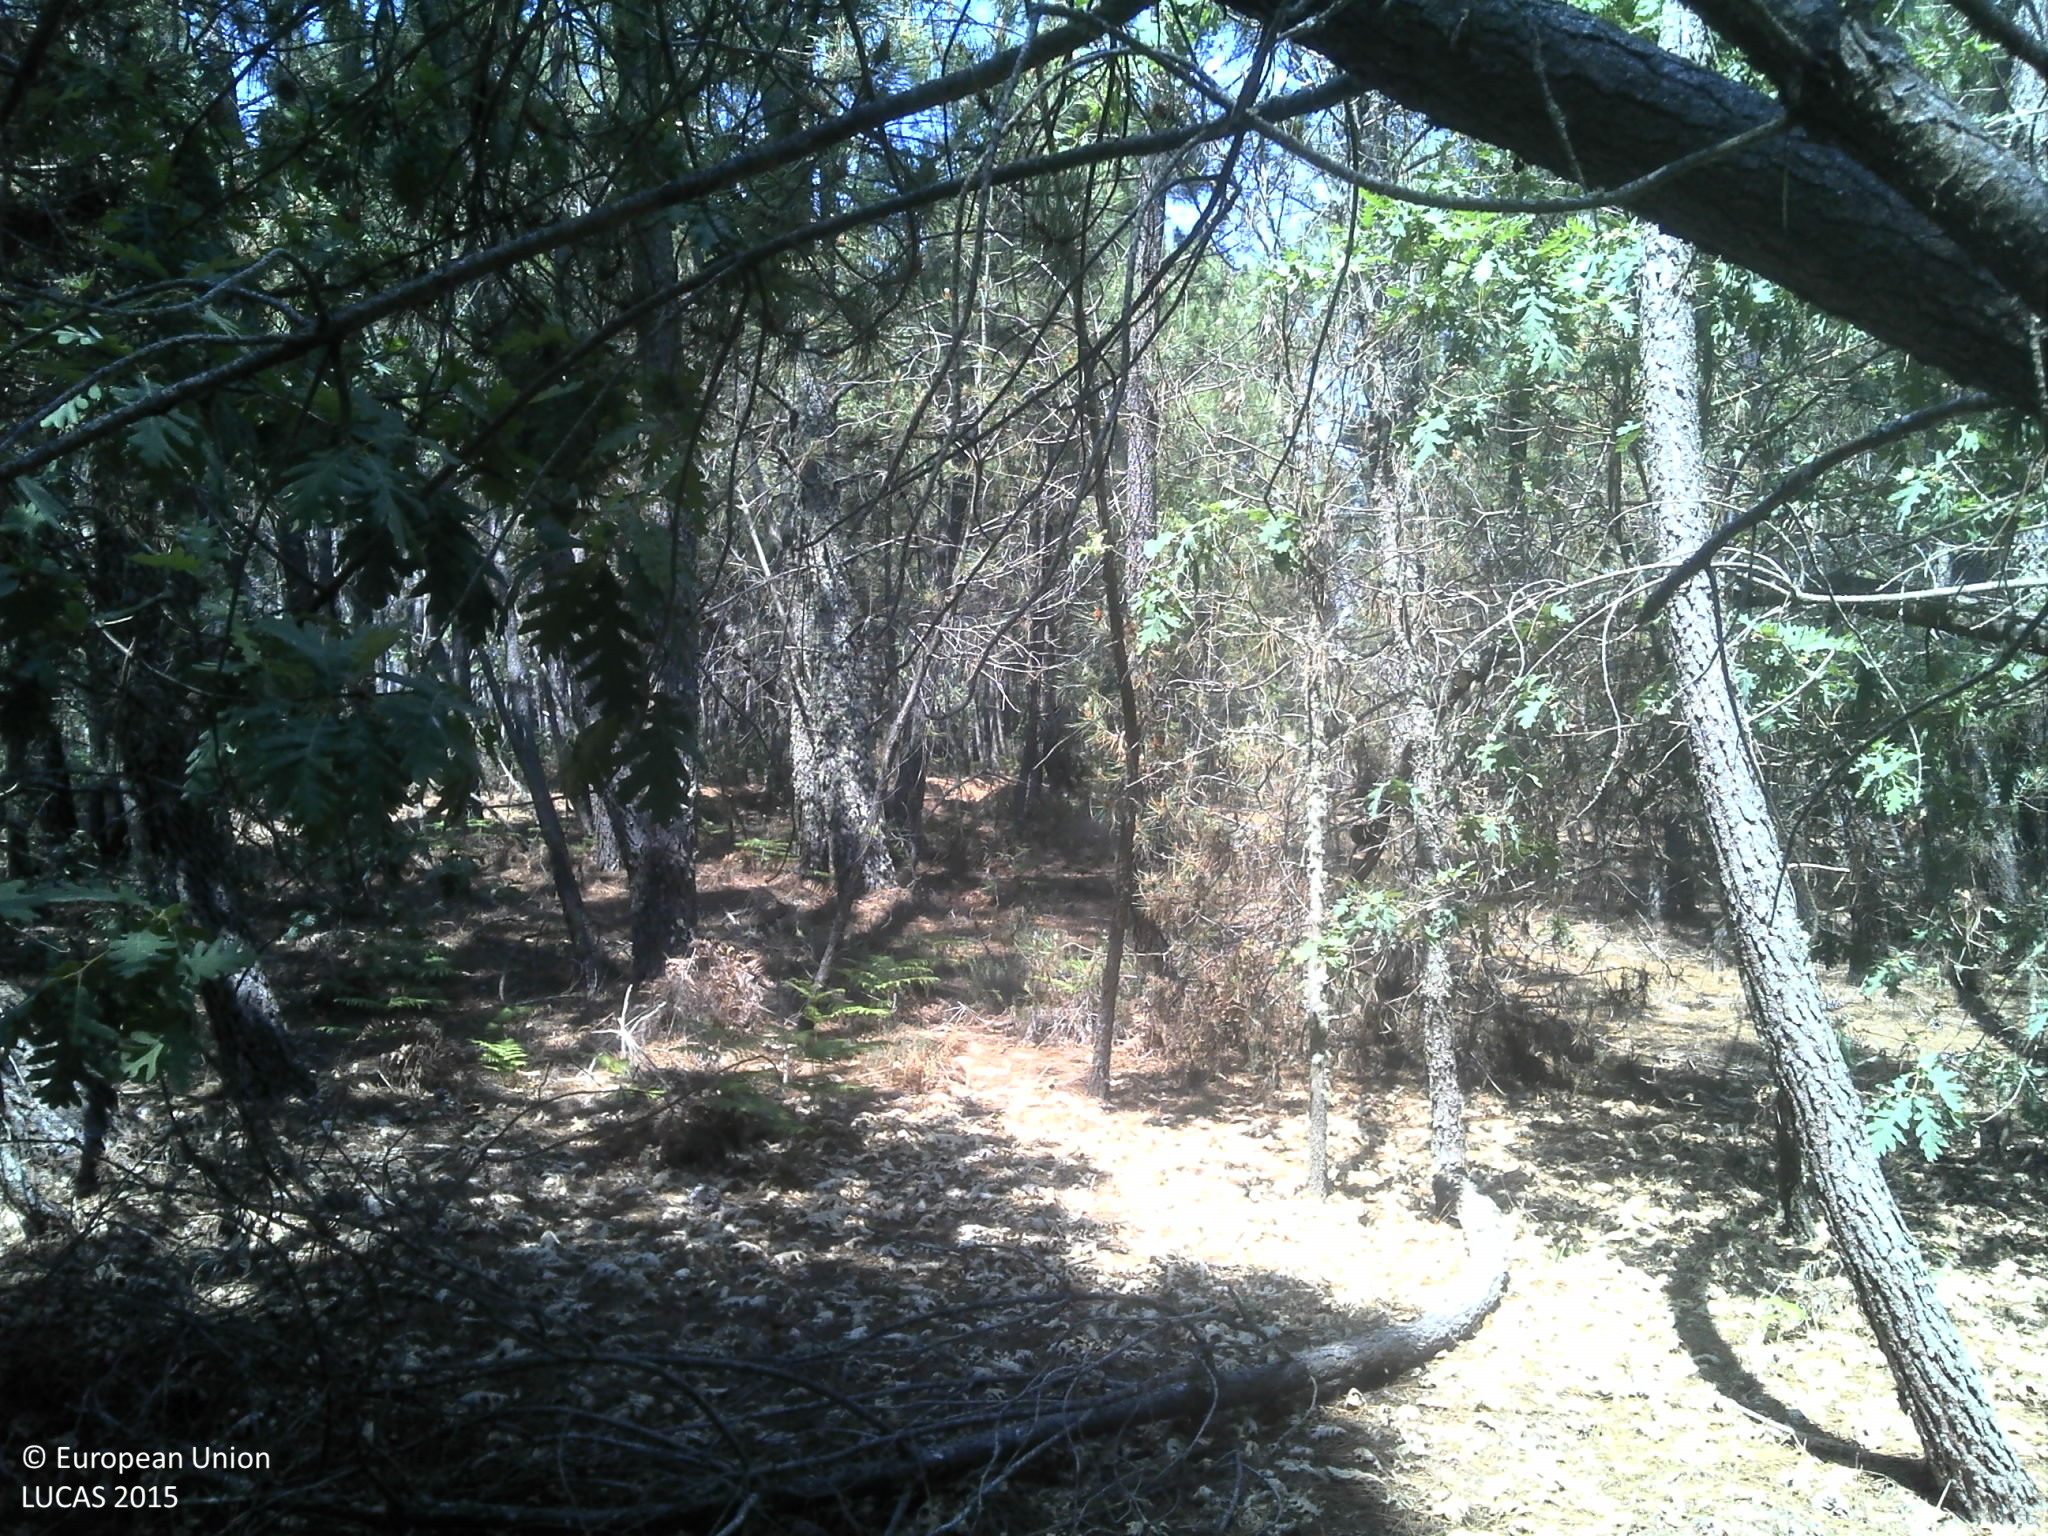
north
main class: Woodland
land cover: Pine dominated coniferous woodland
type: coniferous forest of the mediterranean region
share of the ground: 50 - 75 %
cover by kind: coniferous forest trees 75 %, shrubs 10 %, unconsolidated bare surface 10 %
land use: Forestry
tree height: > 5 m
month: June
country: PT
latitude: 40.3068
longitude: -7.0759
